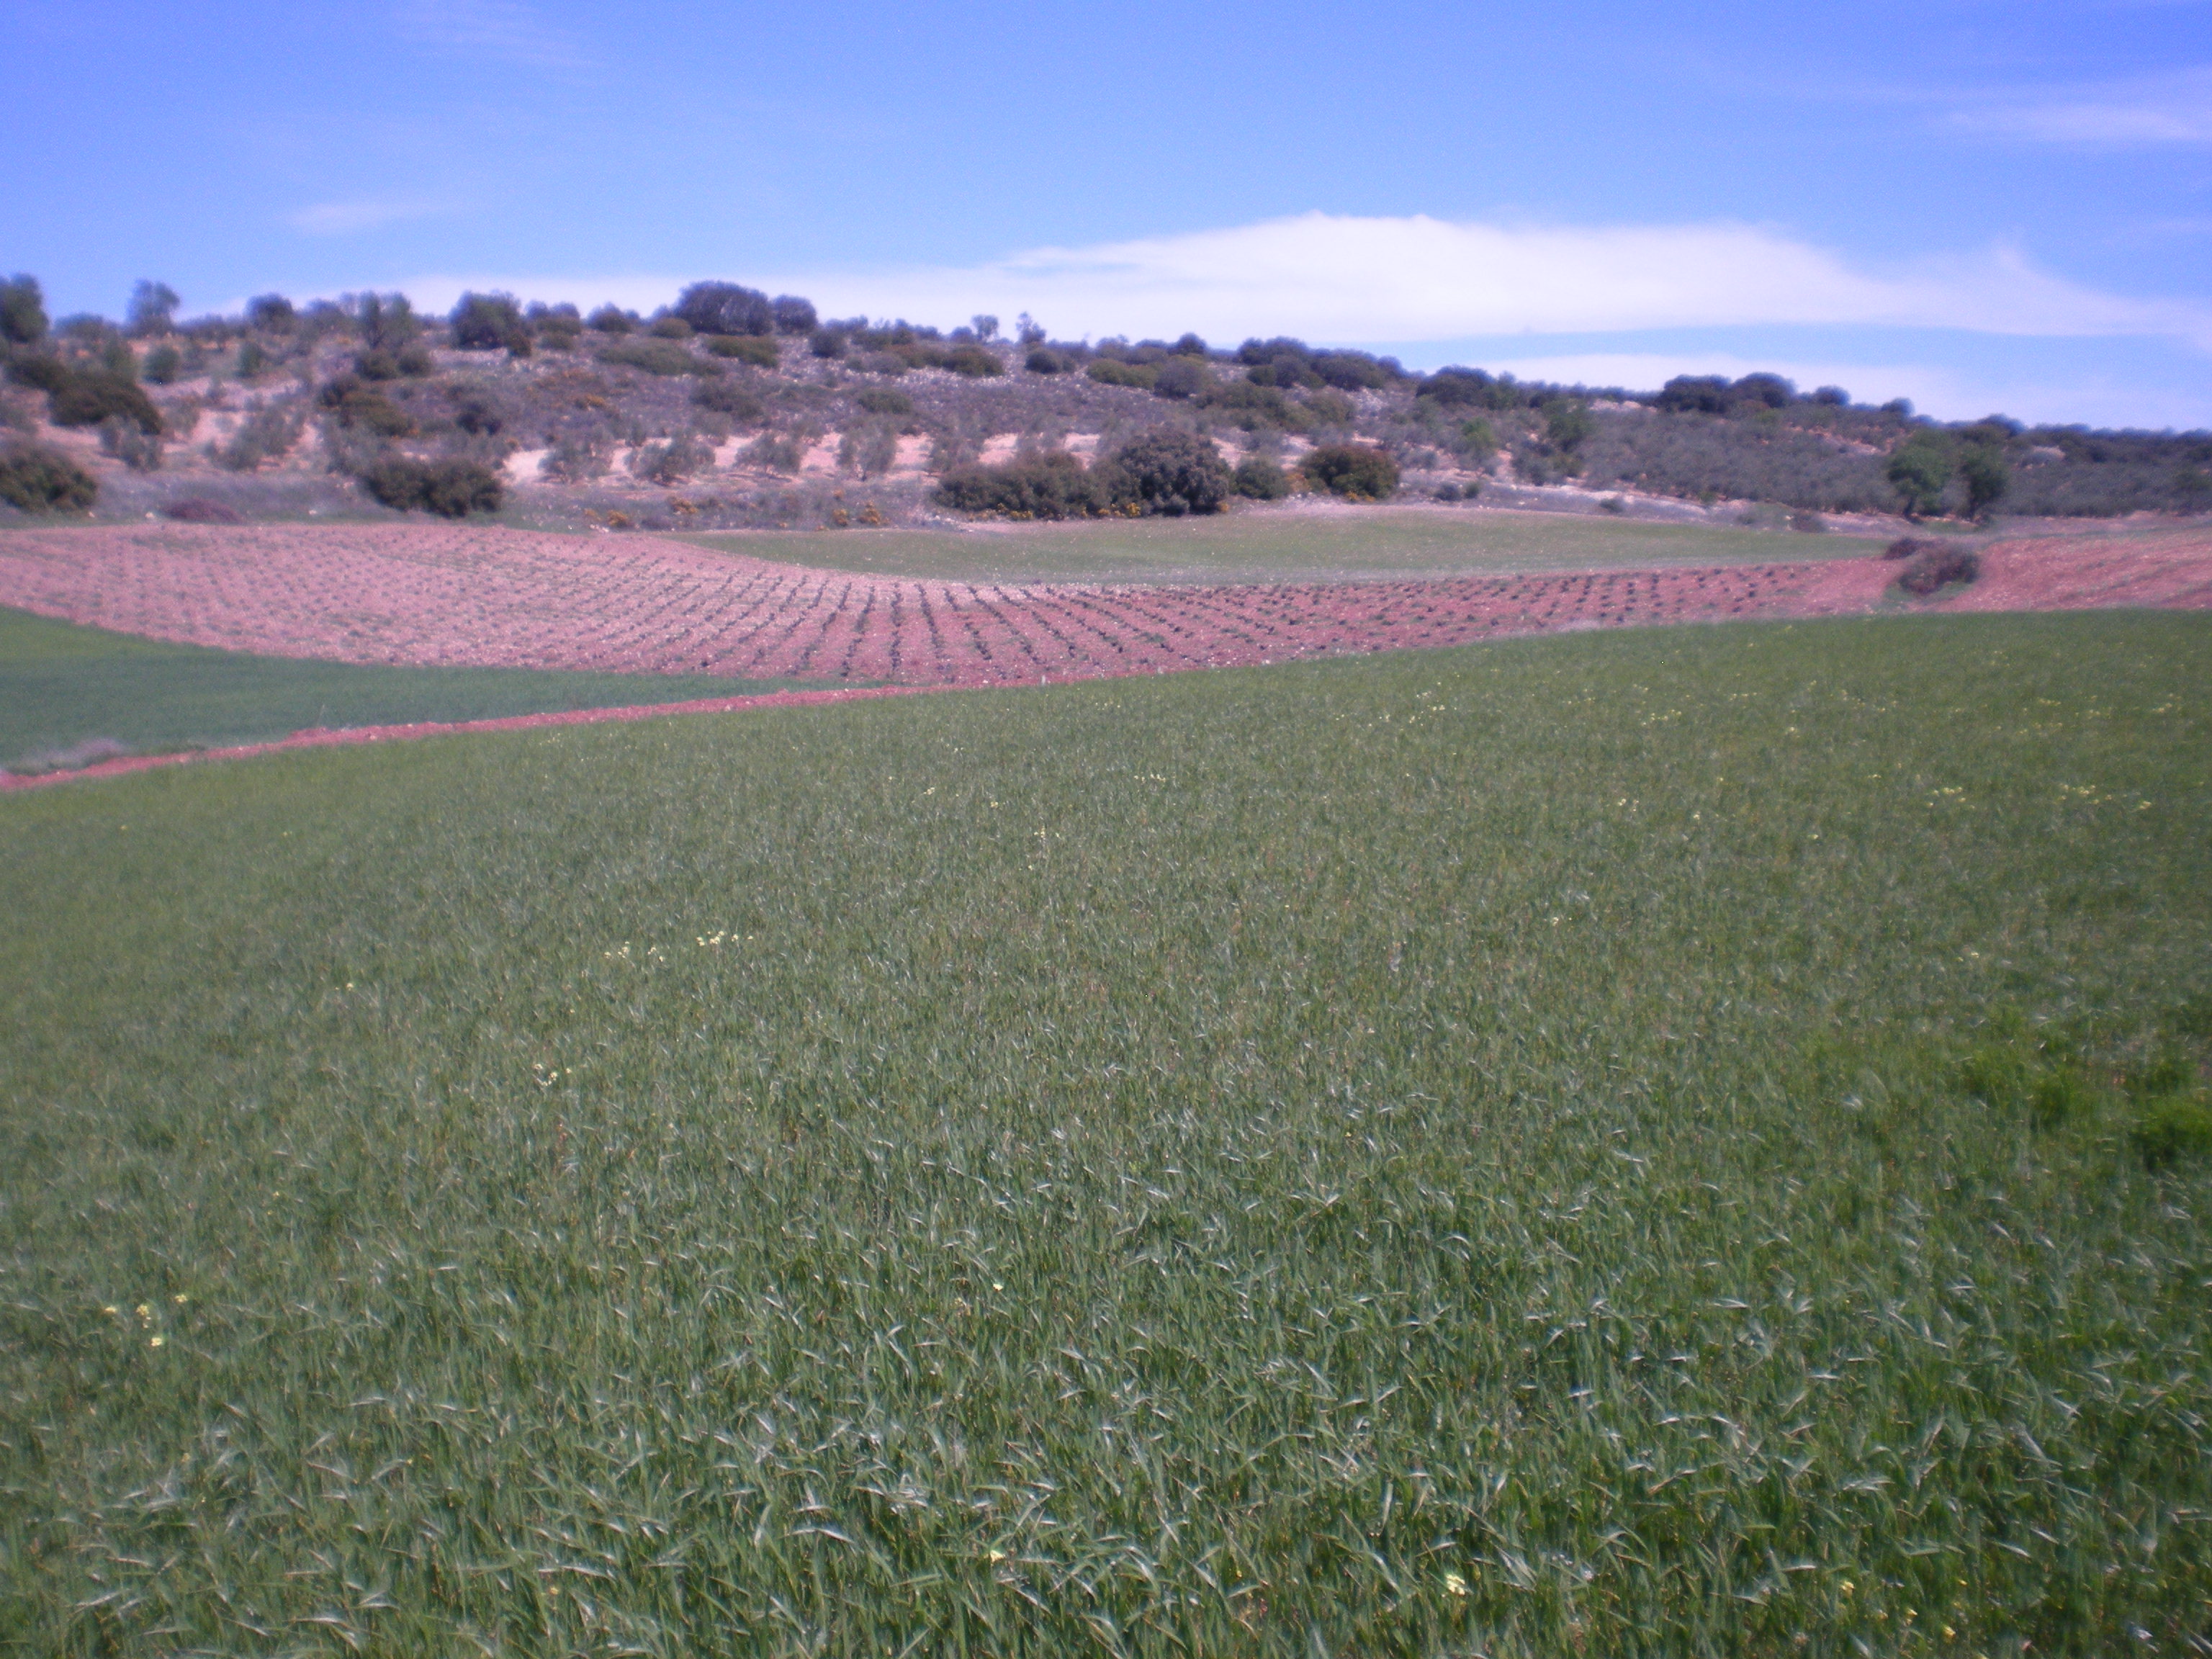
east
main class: Cropland
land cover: Barley
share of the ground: > 75 %
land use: Agriculture (excluding fallow land and kitchen gardens)
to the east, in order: Grass margins; Barley; Grass margins; Rivers and streams; Grass margins; Barley; Vineyards; Spontaneously vegetated surfaces; Broadleaved woodland; Olive groves
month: April
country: ES
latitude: 38.6272
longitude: -2.8806
